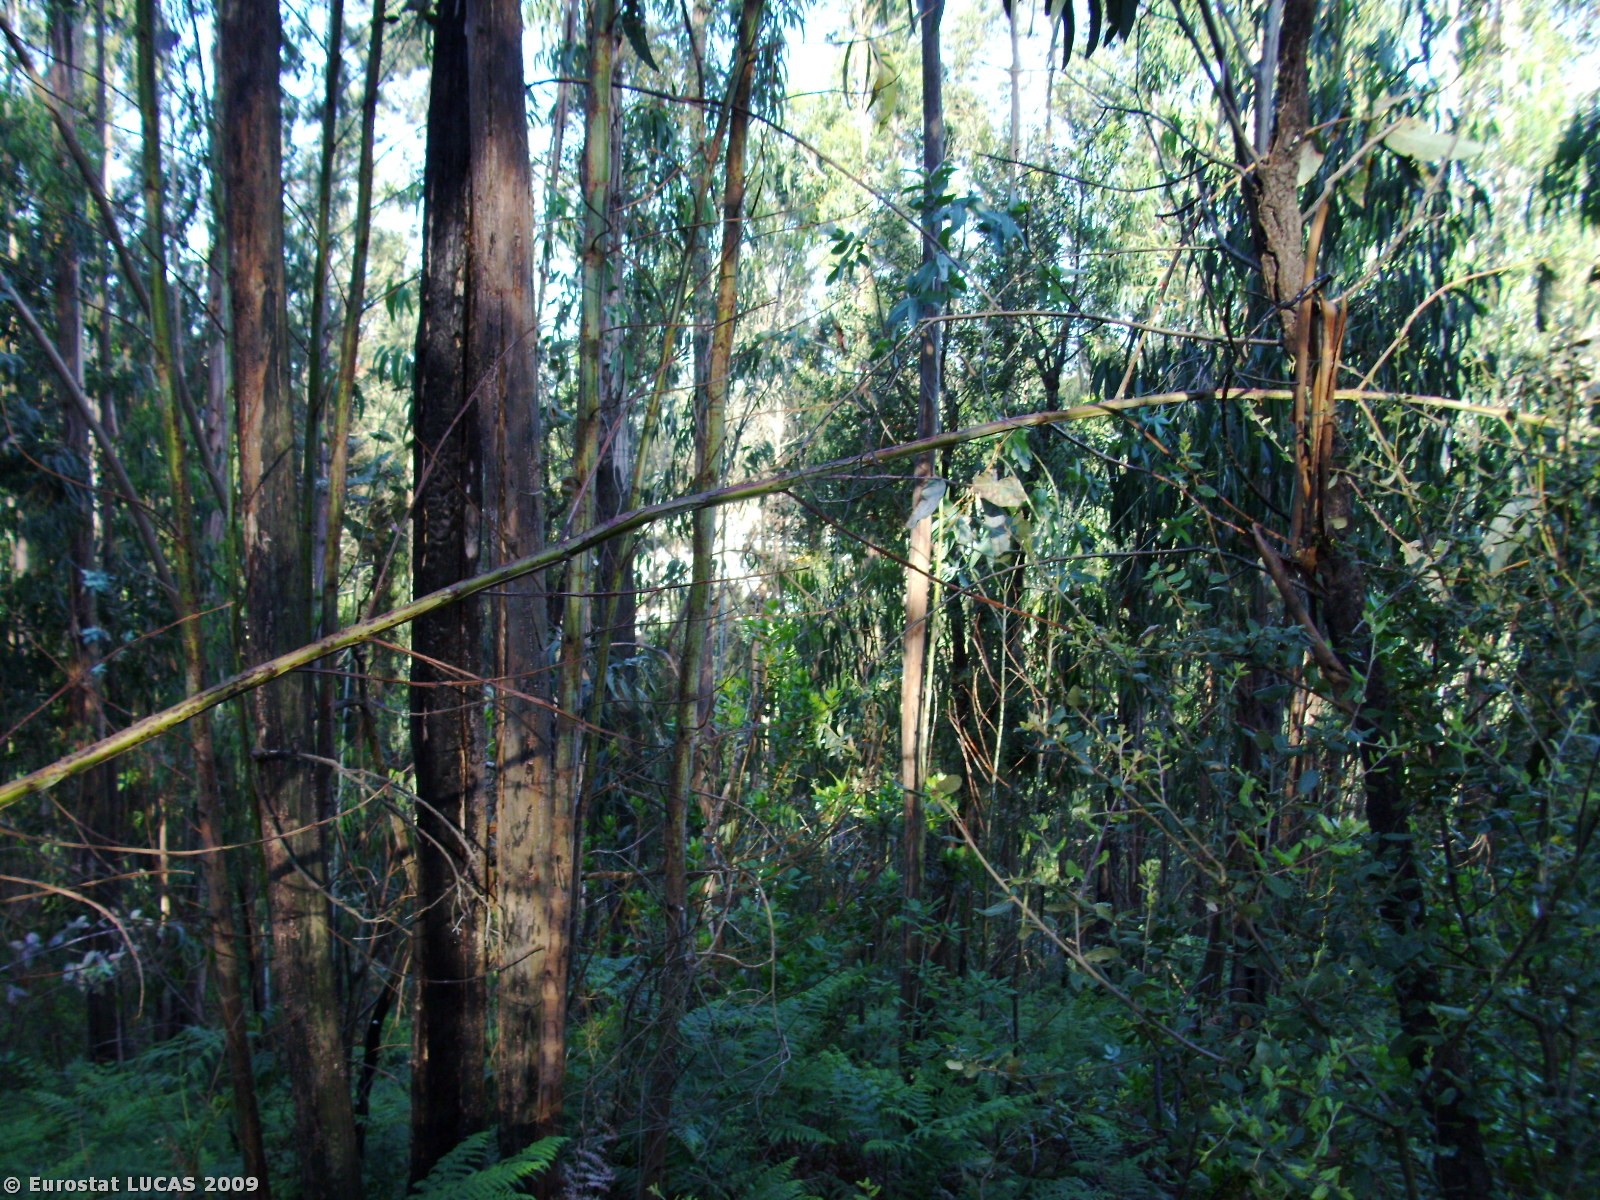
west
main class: Woodland
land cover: Broadleaved woodland
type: plantations and self-sown exotic forest
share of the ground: 50 - 75 %
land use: Forestry
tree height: > 5 m
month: May
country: PT
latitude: 40.8282
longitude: -8.4629
